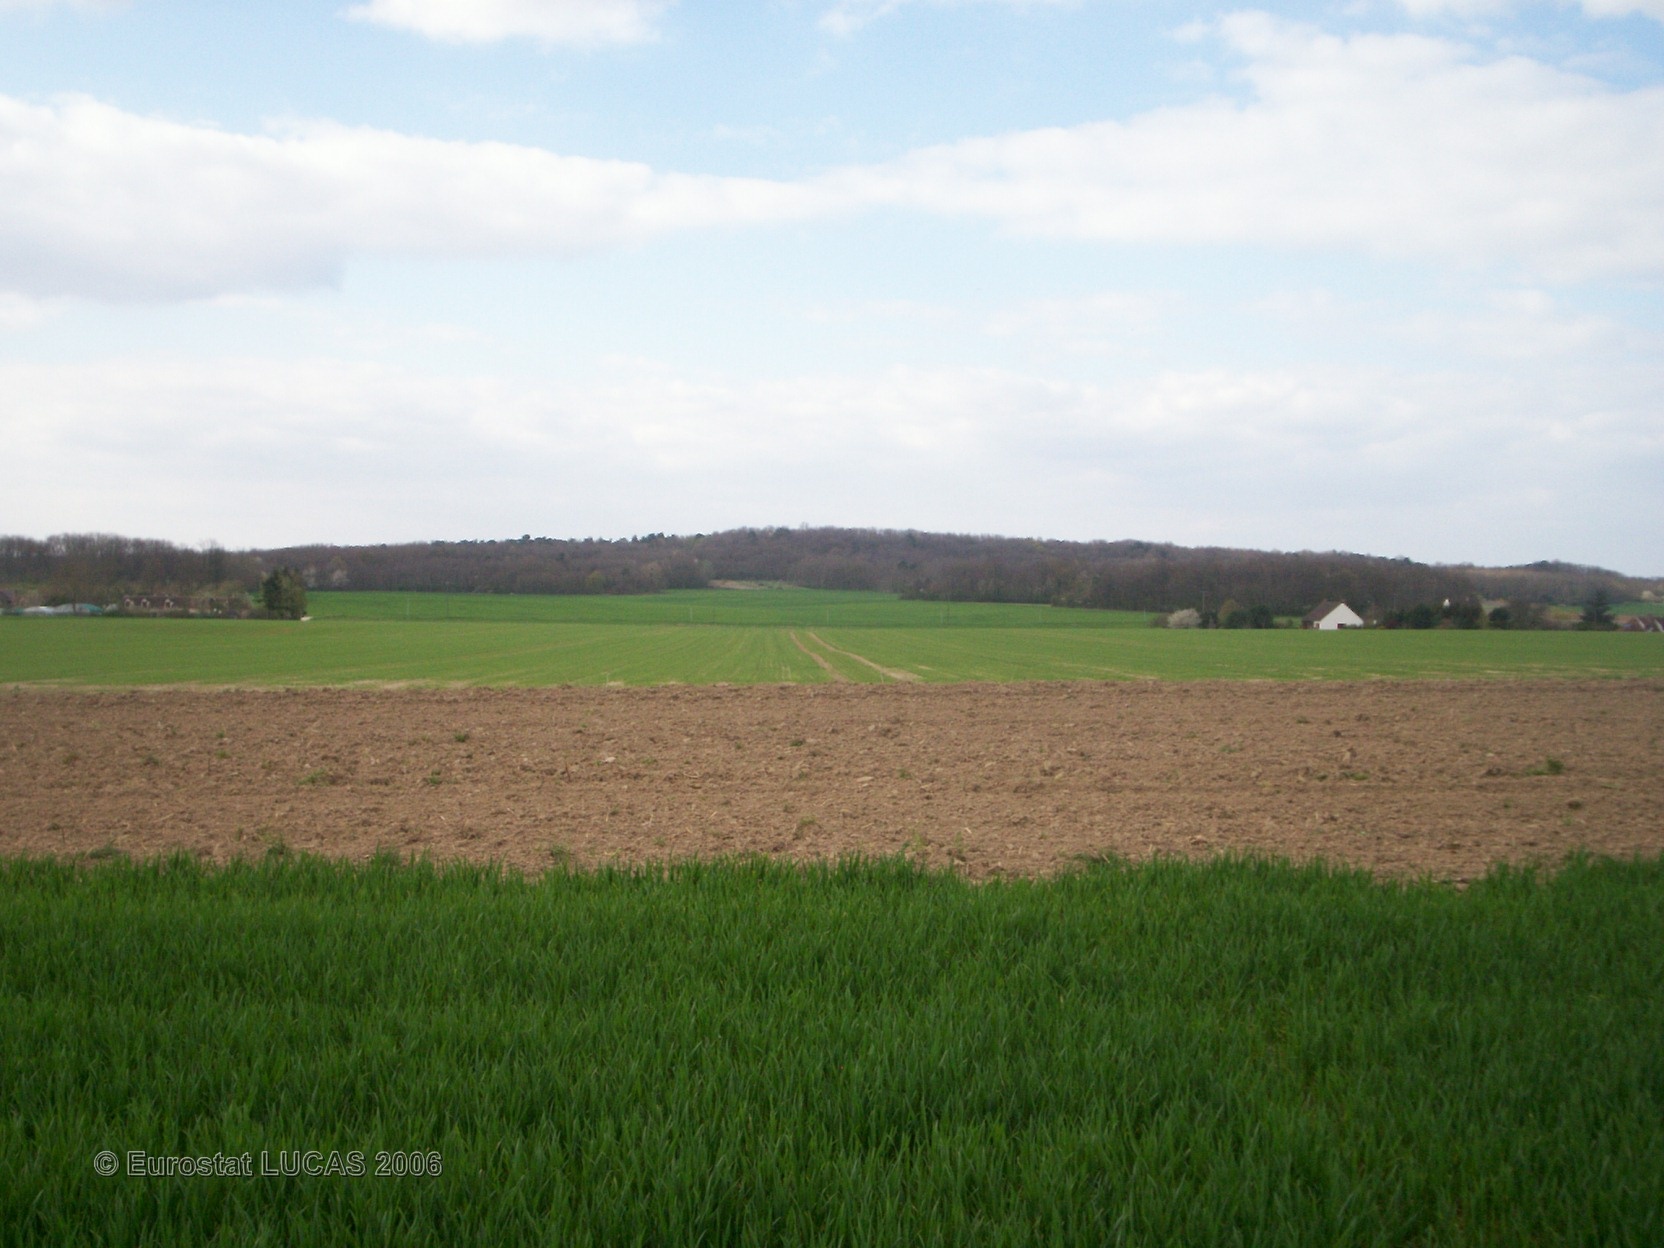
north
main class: Cropland
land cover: Common wheat
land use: Agriculture (excluding fallow land and kitchen gardens)
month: April
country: FR
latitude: 48.3008
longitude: 2.8873
